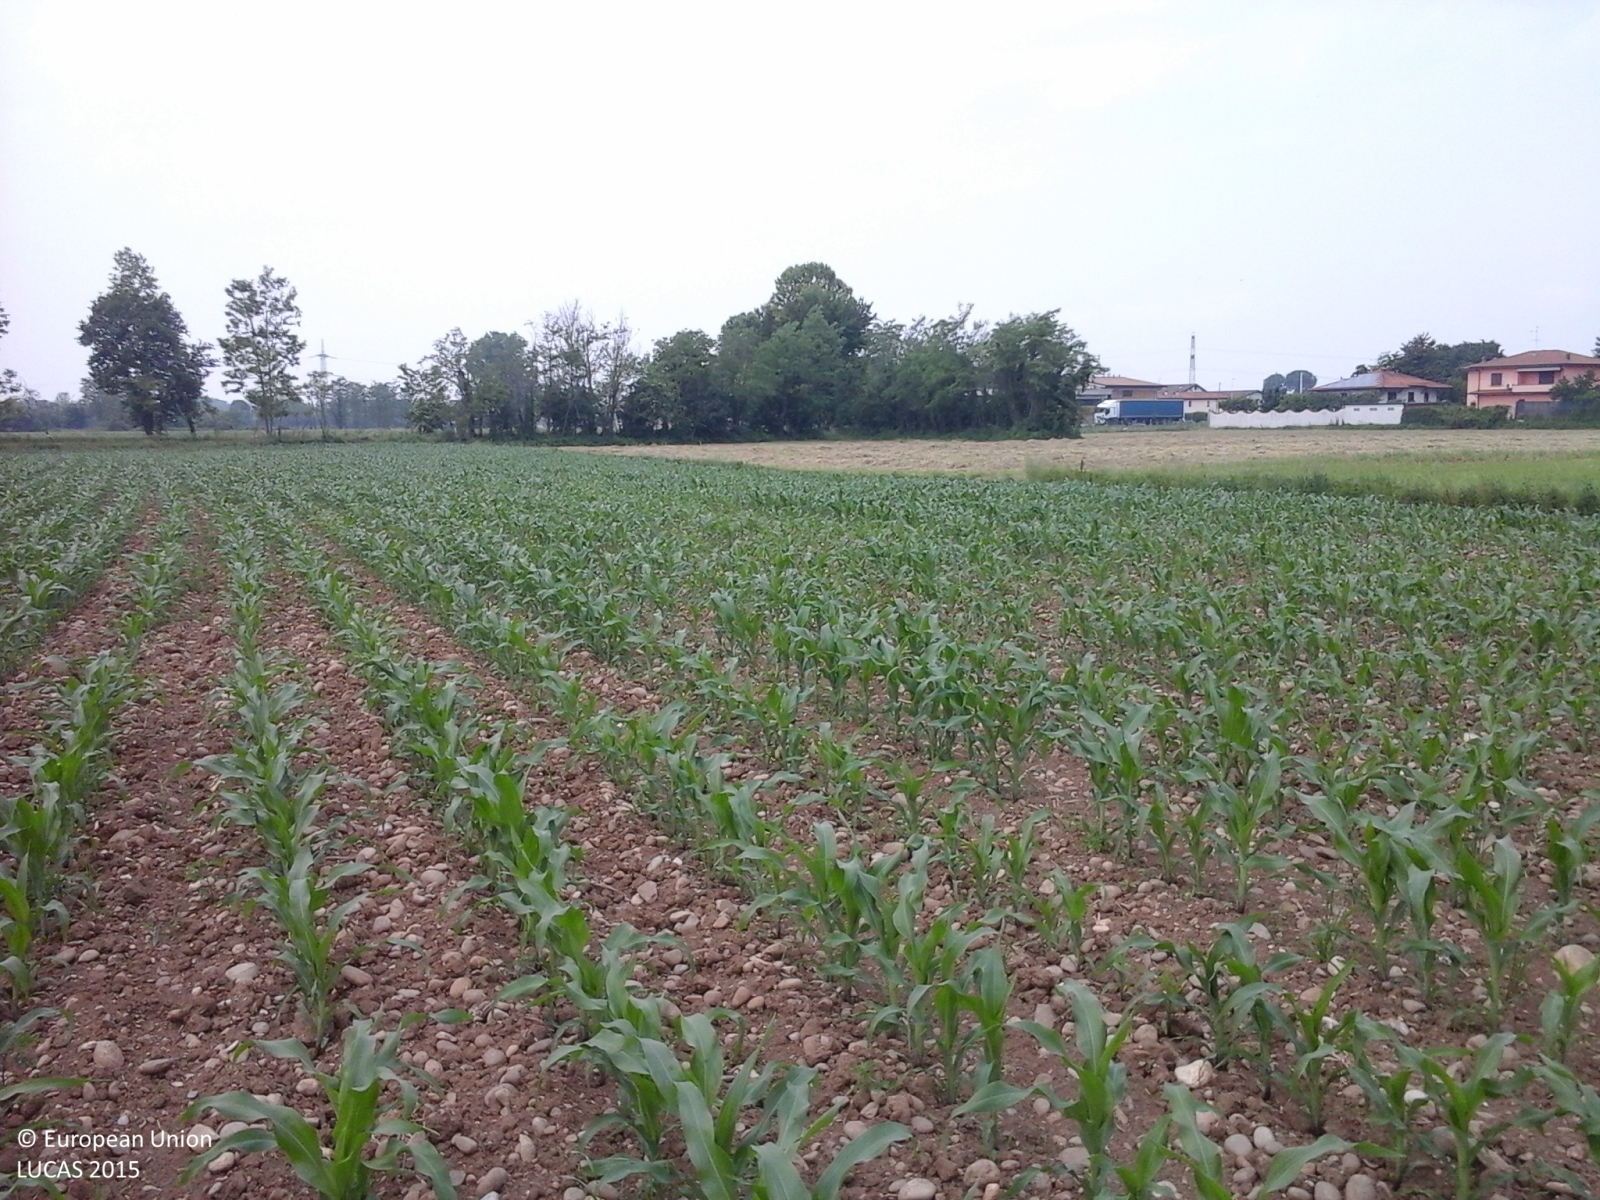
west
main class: Cropland
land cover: Maize
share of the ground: 10 - 25 %
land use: Agriculture (excluding fallow land and kitchen gardens)
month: May
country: IT
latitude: 45.5395
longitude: 9.5525
